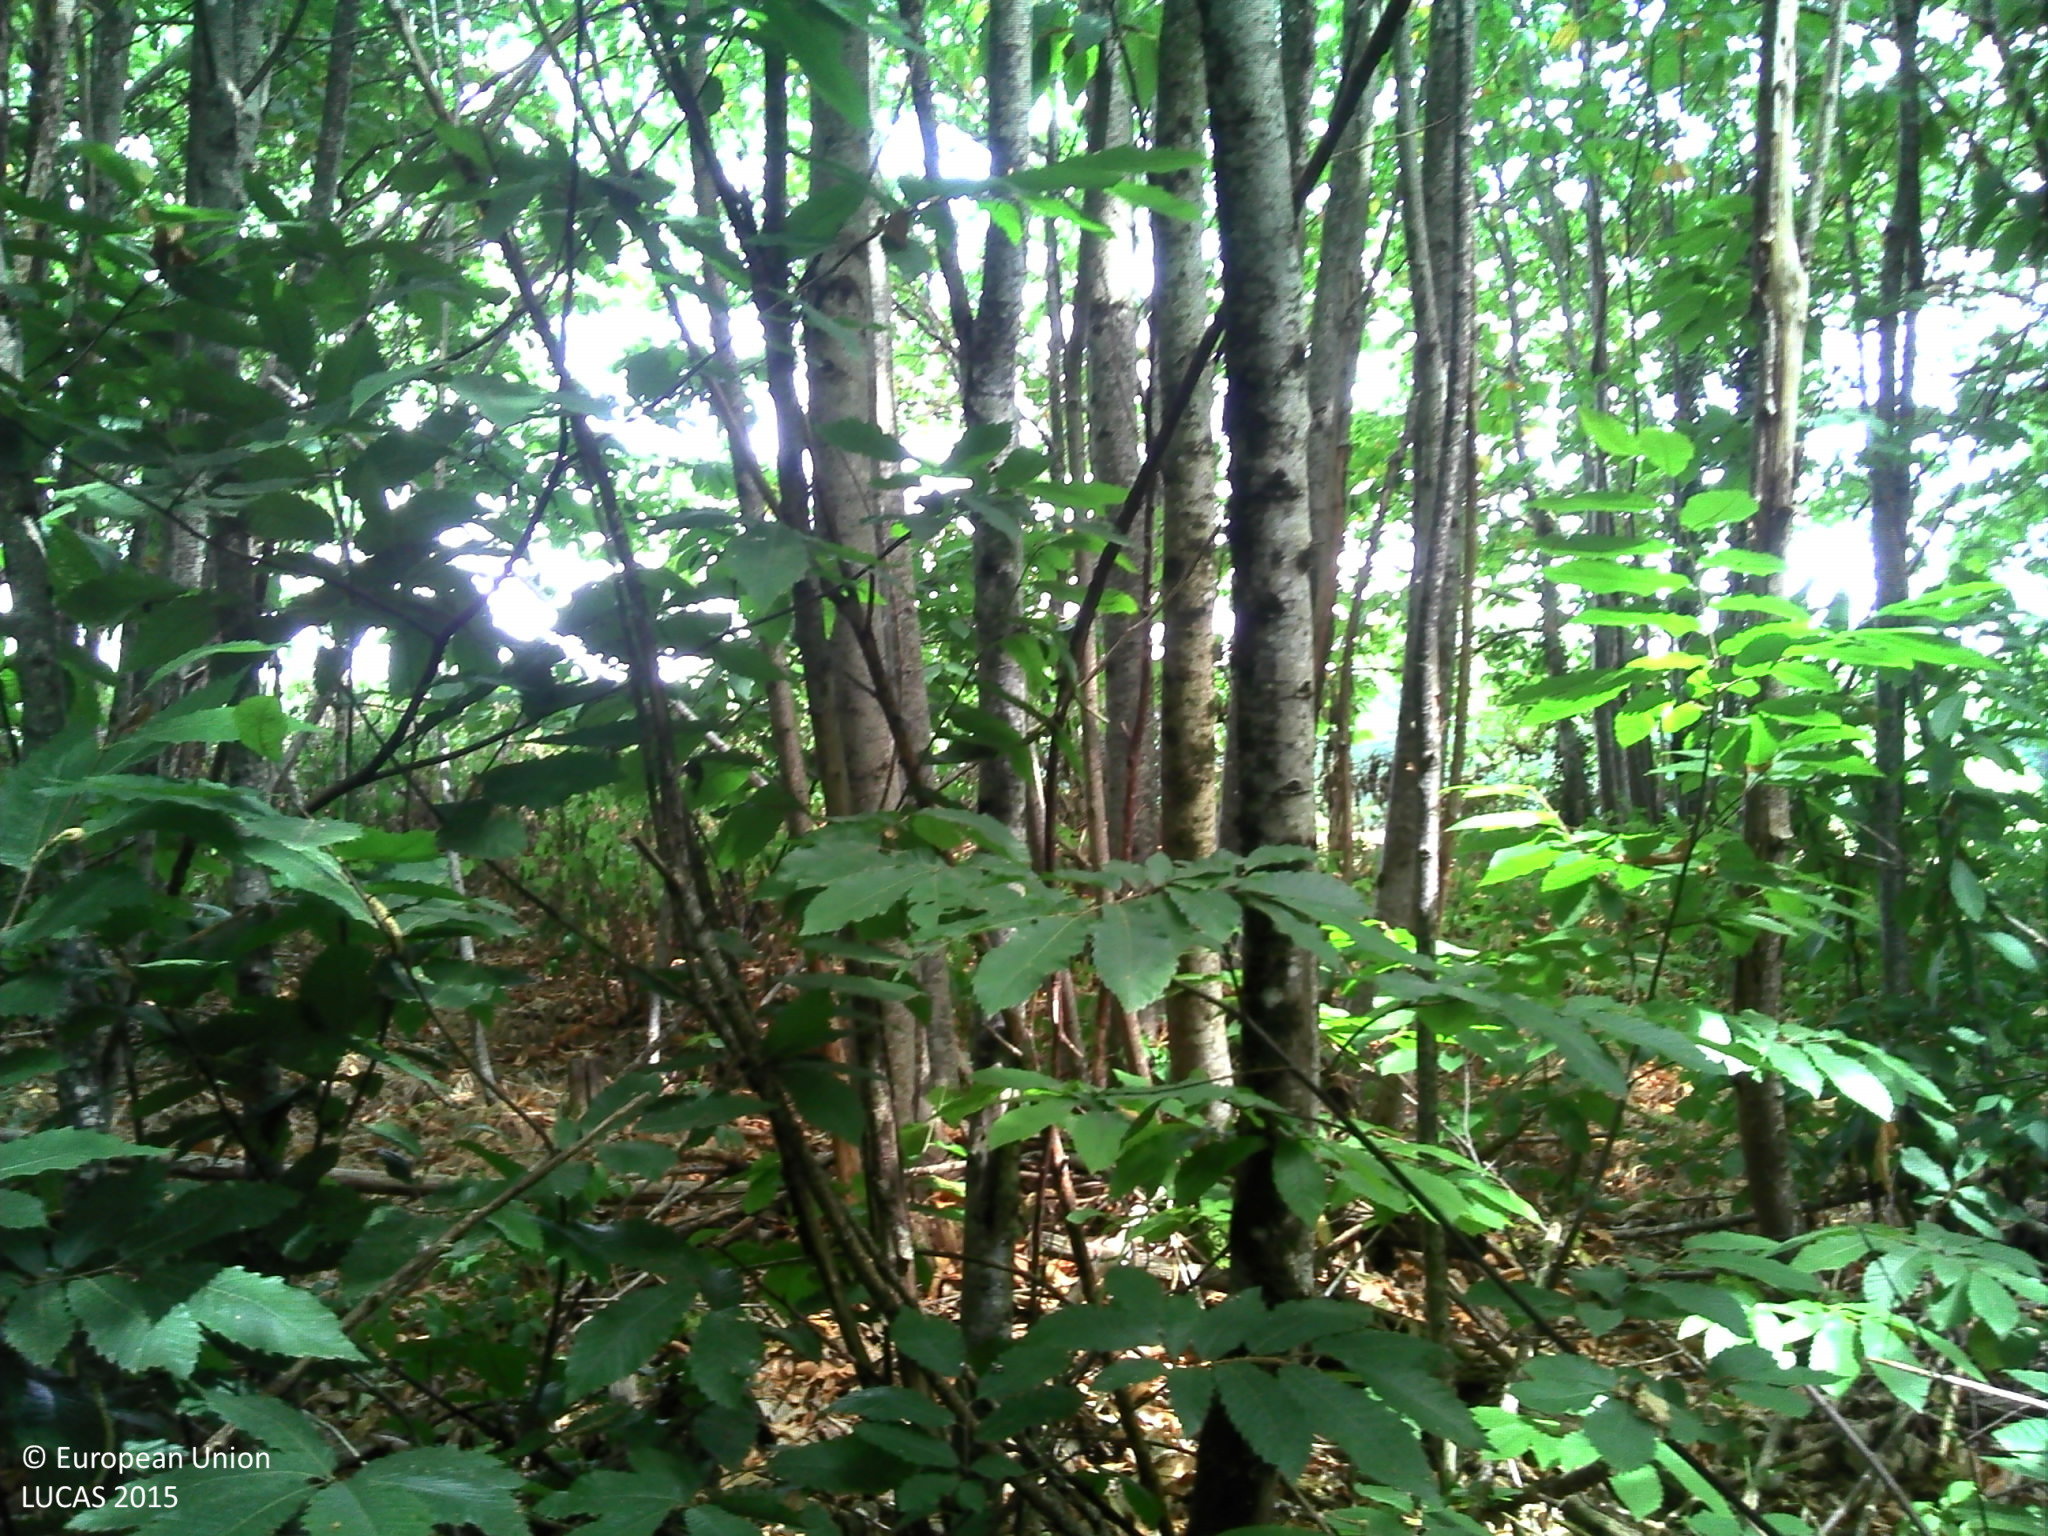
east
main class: Woodland
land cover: Broadleaved woodland
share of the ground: > 75 %
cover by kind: broadleaved forest trees 40 %, herbaceous plants 30 %, lichens and mosses 20 %, unconsolidated bare surface 10 %
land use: Forestry
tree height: > 5 m
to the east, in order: Broadleaved woodland; Fences; Grassland without tree/shrub cover; Lines of trees; Grassland without tree/shrub cover; Electric lines; Grassland without tree/shrub cover; Fences; Grassland without tree/shrub cover
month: July
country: FR
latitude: 45.6847
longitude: 1.0407
